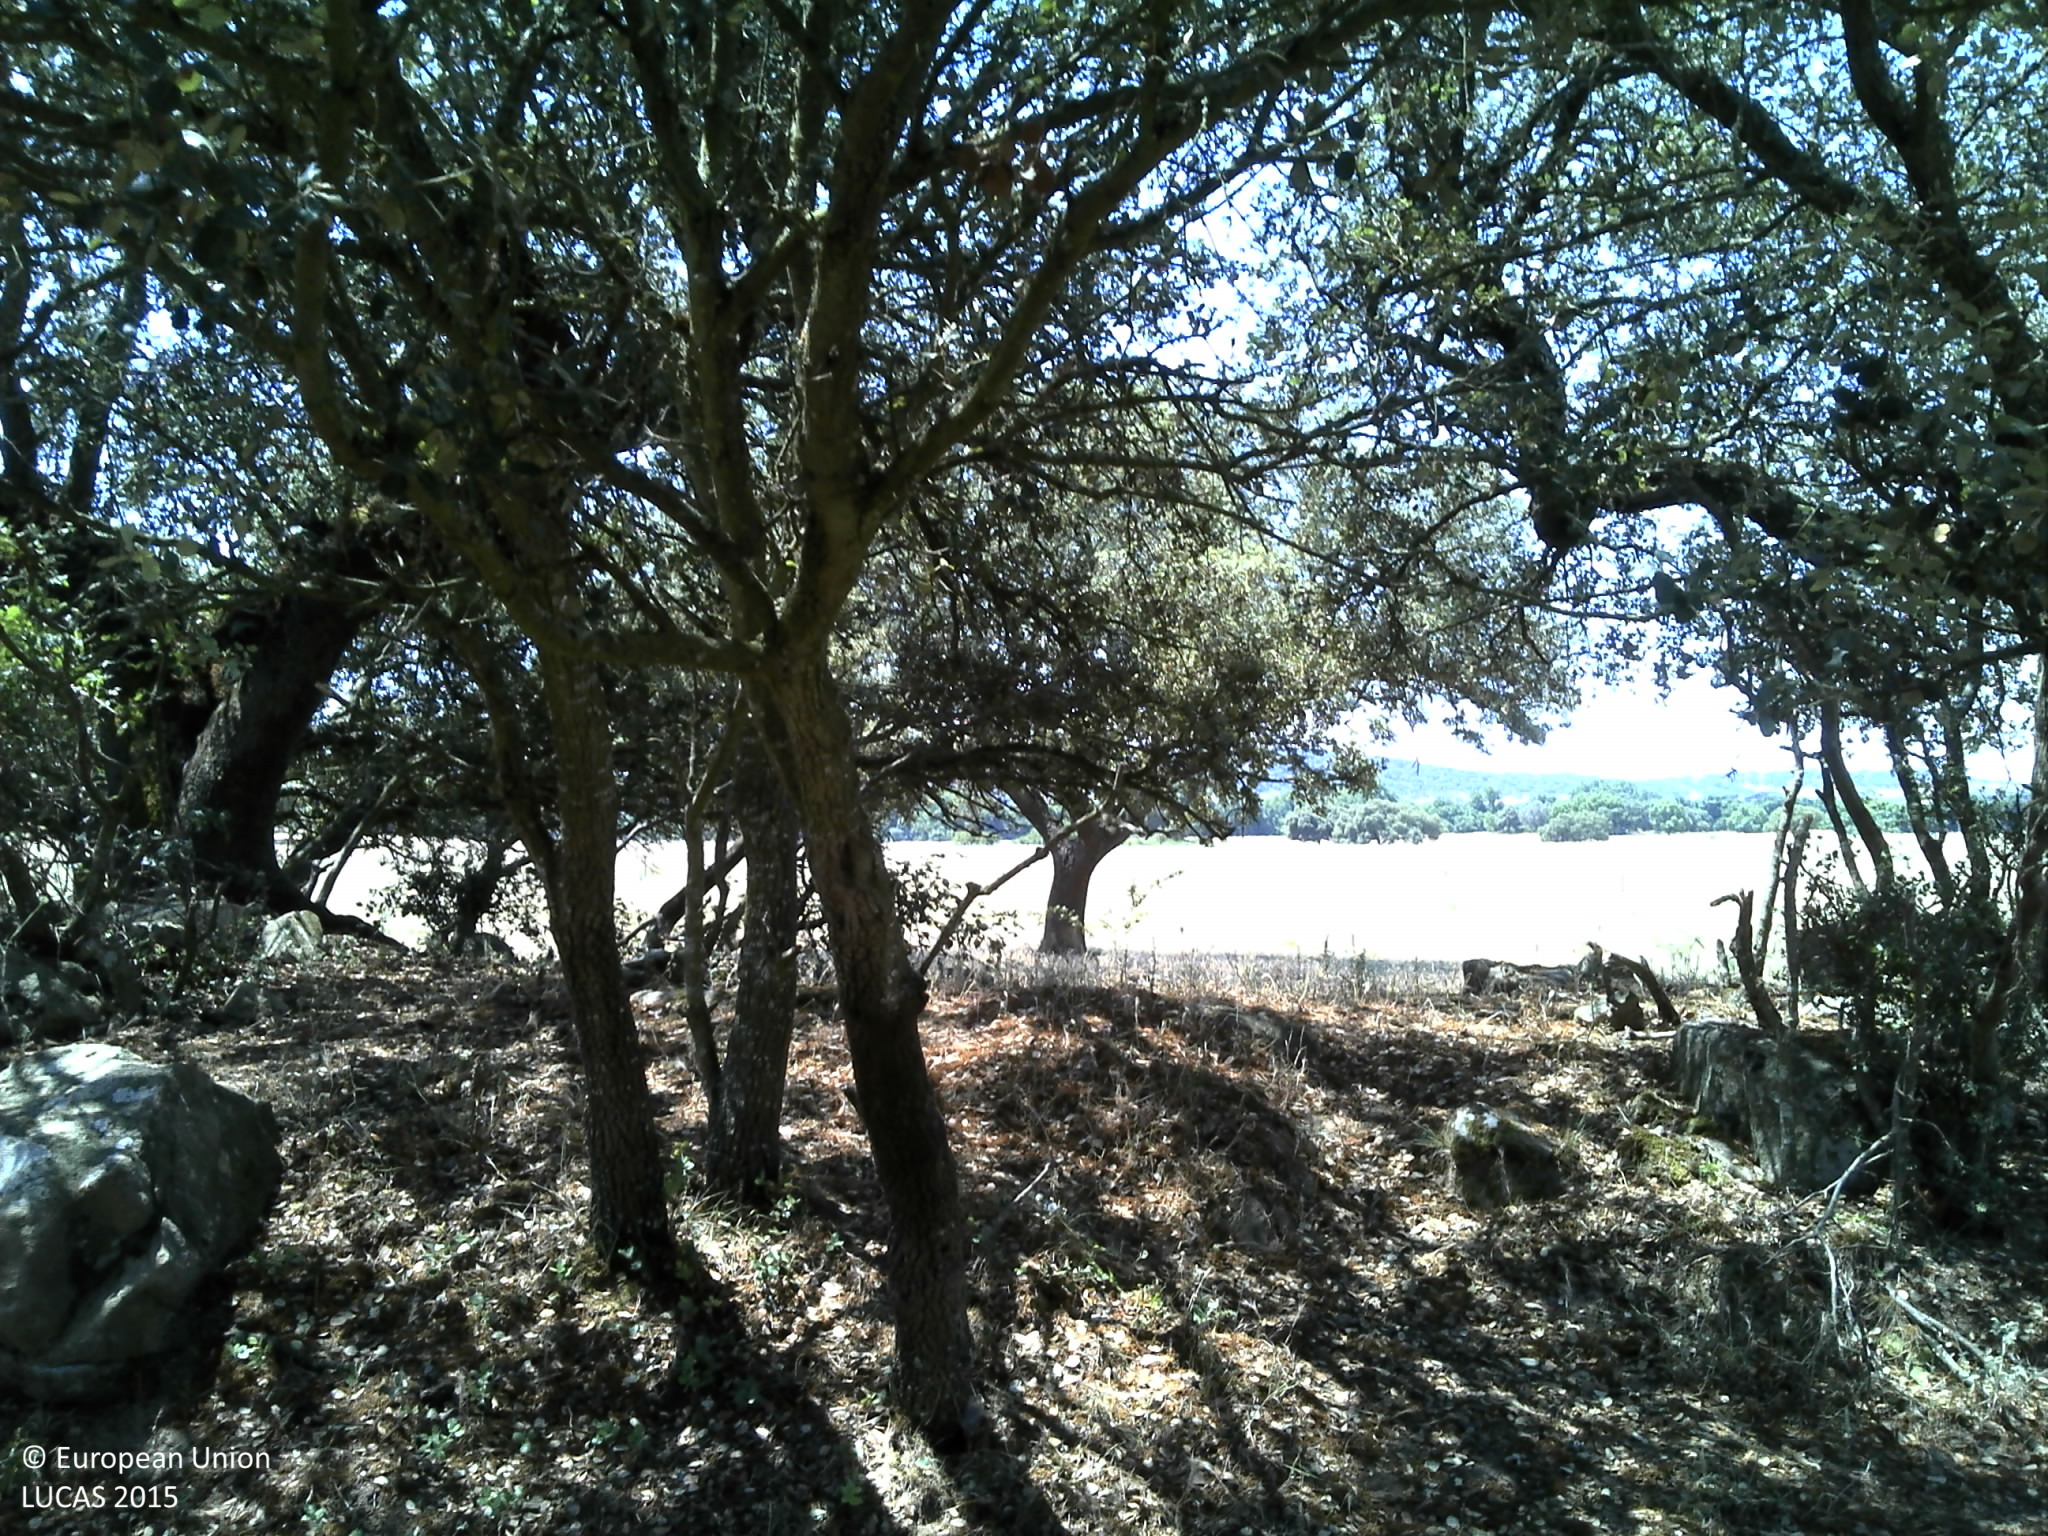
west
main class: Woodland
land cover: Broadleaved woodland
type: broadleaved evergreen forest
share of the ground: 25 - 50 %
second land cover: Grassland without tree/shrub cover
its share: 25 - 50 %
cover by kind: herbaceous plants 50 %, broadleaved forest trees 30 %, unconsolidated bare surface 20 %
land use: Forestry
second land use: Agriculture (excluding fallow land and kitchen gardens)
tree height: > 5 m
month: June
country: PT
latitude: 38.6561
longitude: -8.1222
